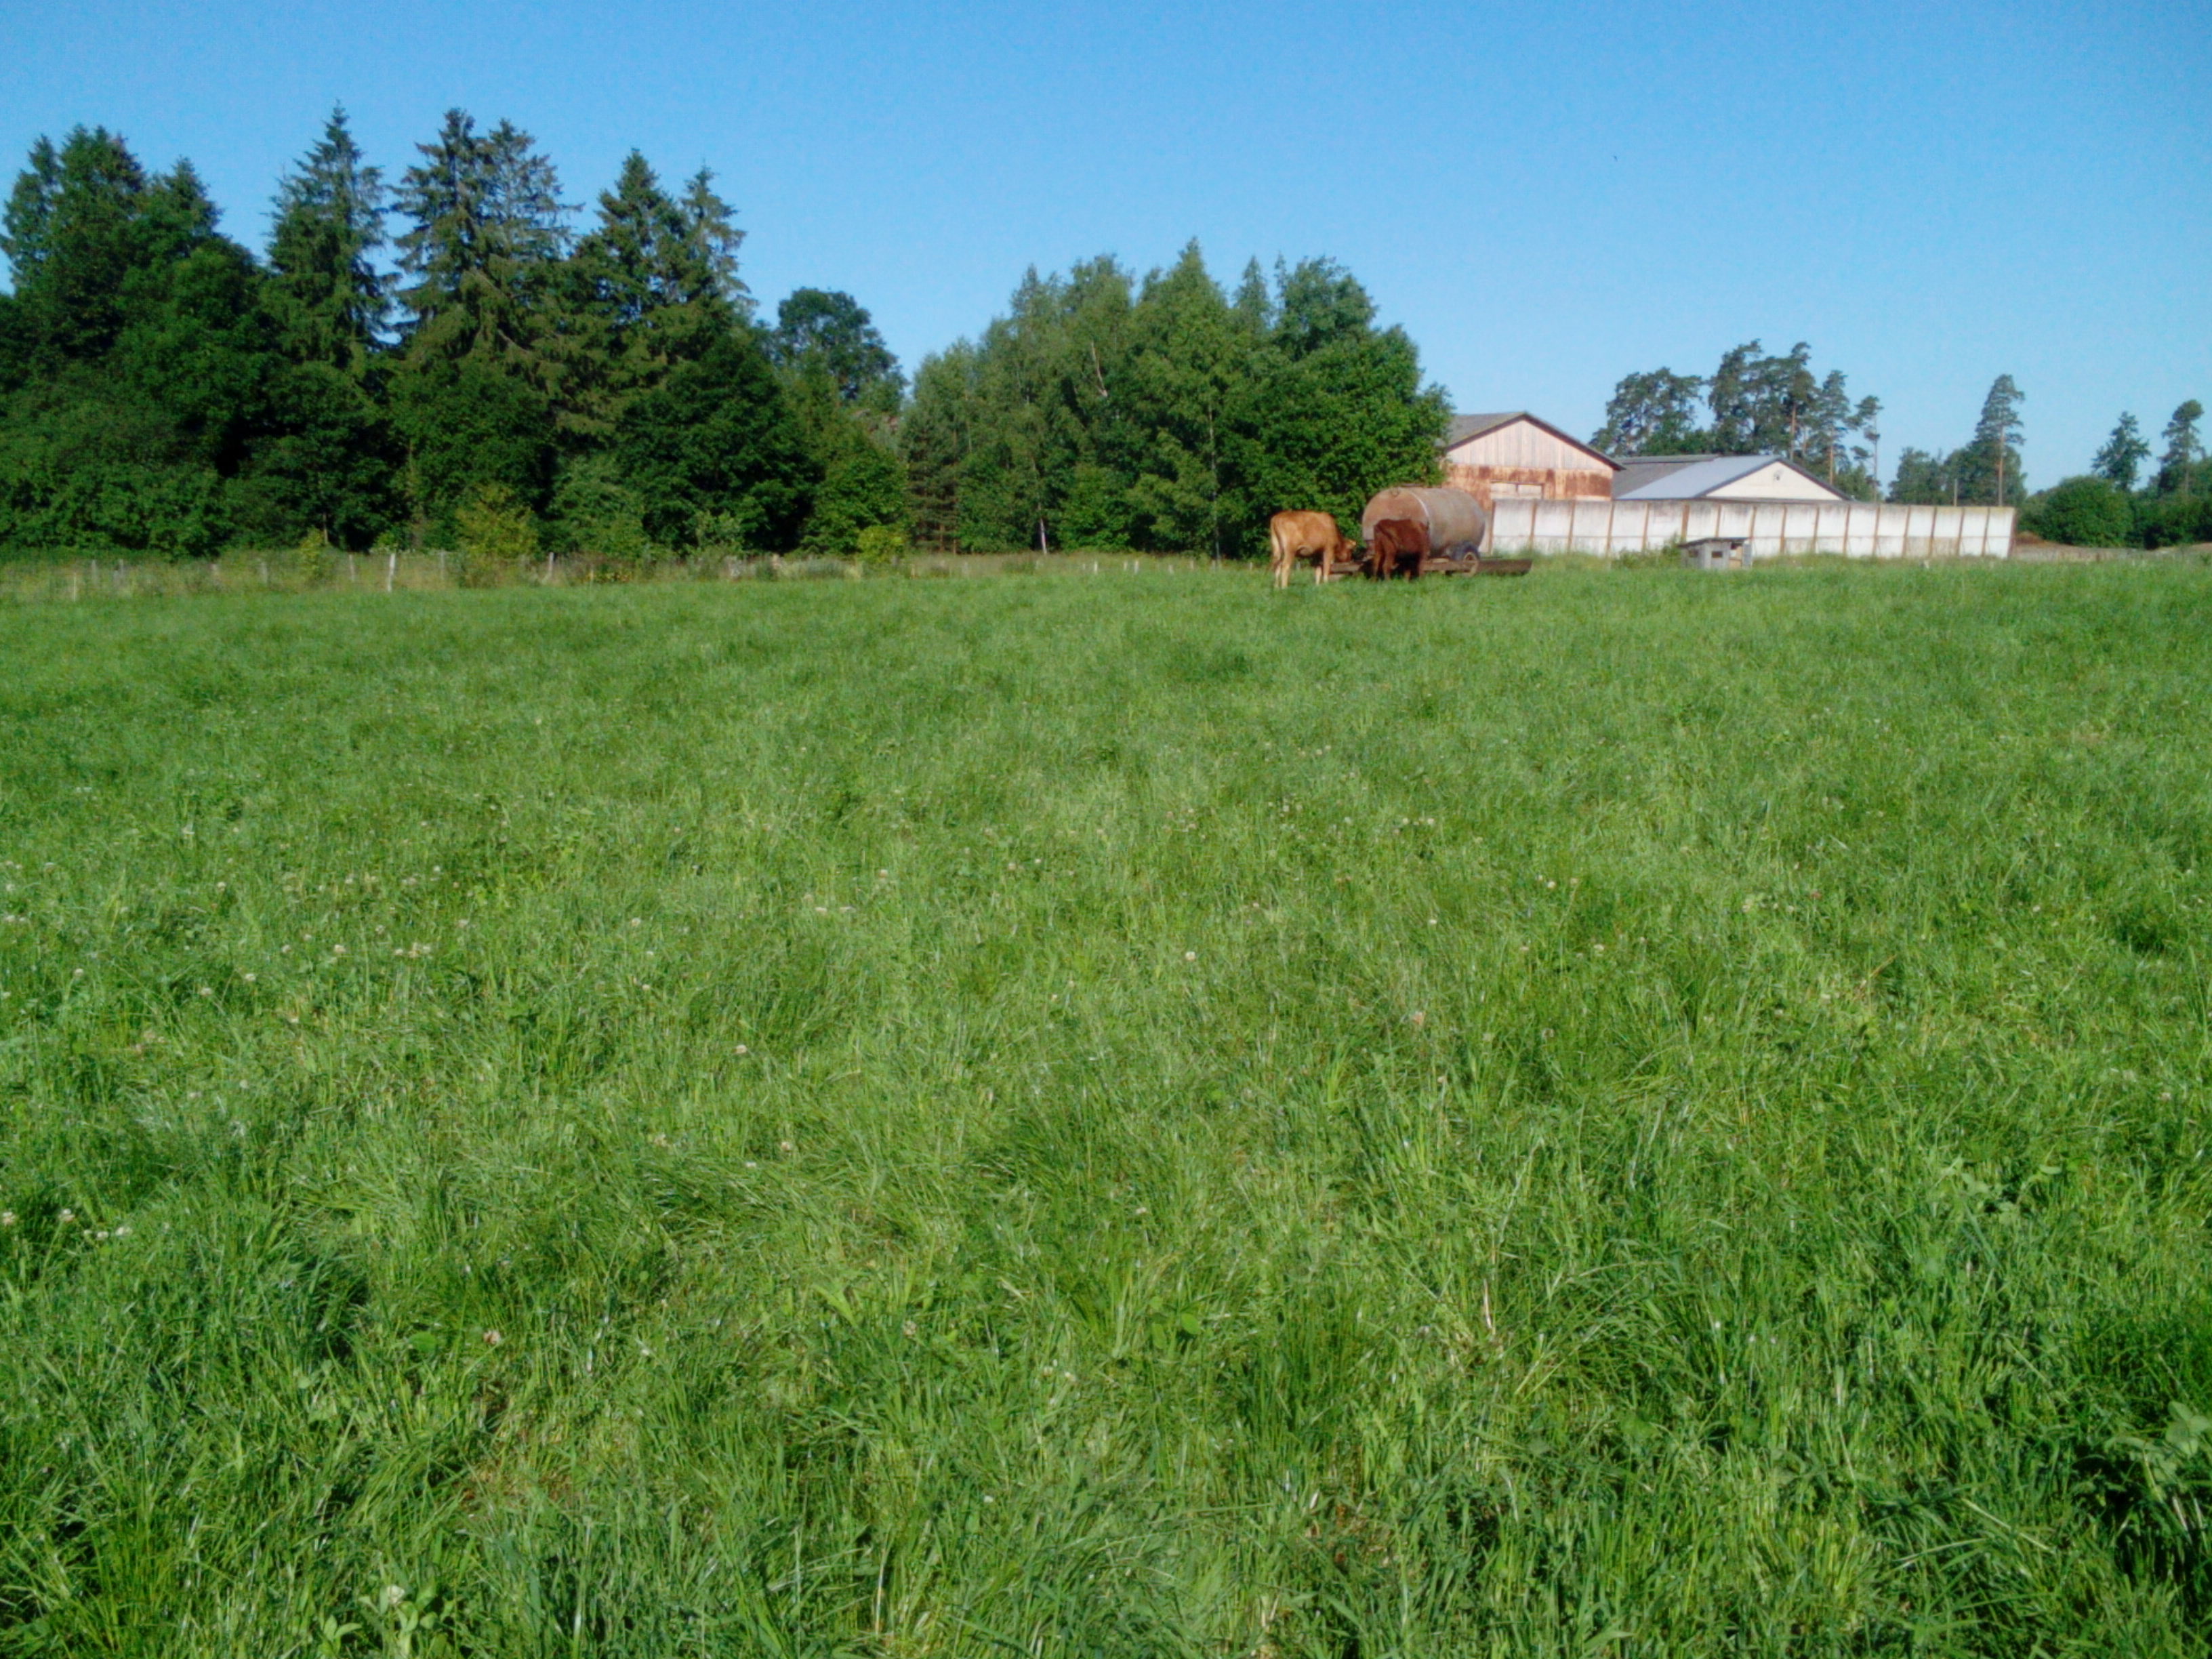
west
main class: Grassland
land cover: Grassland without tree/shrub cover
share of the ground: > 75 %
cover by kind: herbaceous plants 100 %
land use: Agriculture (excluding fallow land and kitchen gardens)
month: July
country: LV
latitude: 56.4465
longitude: 22.1375
